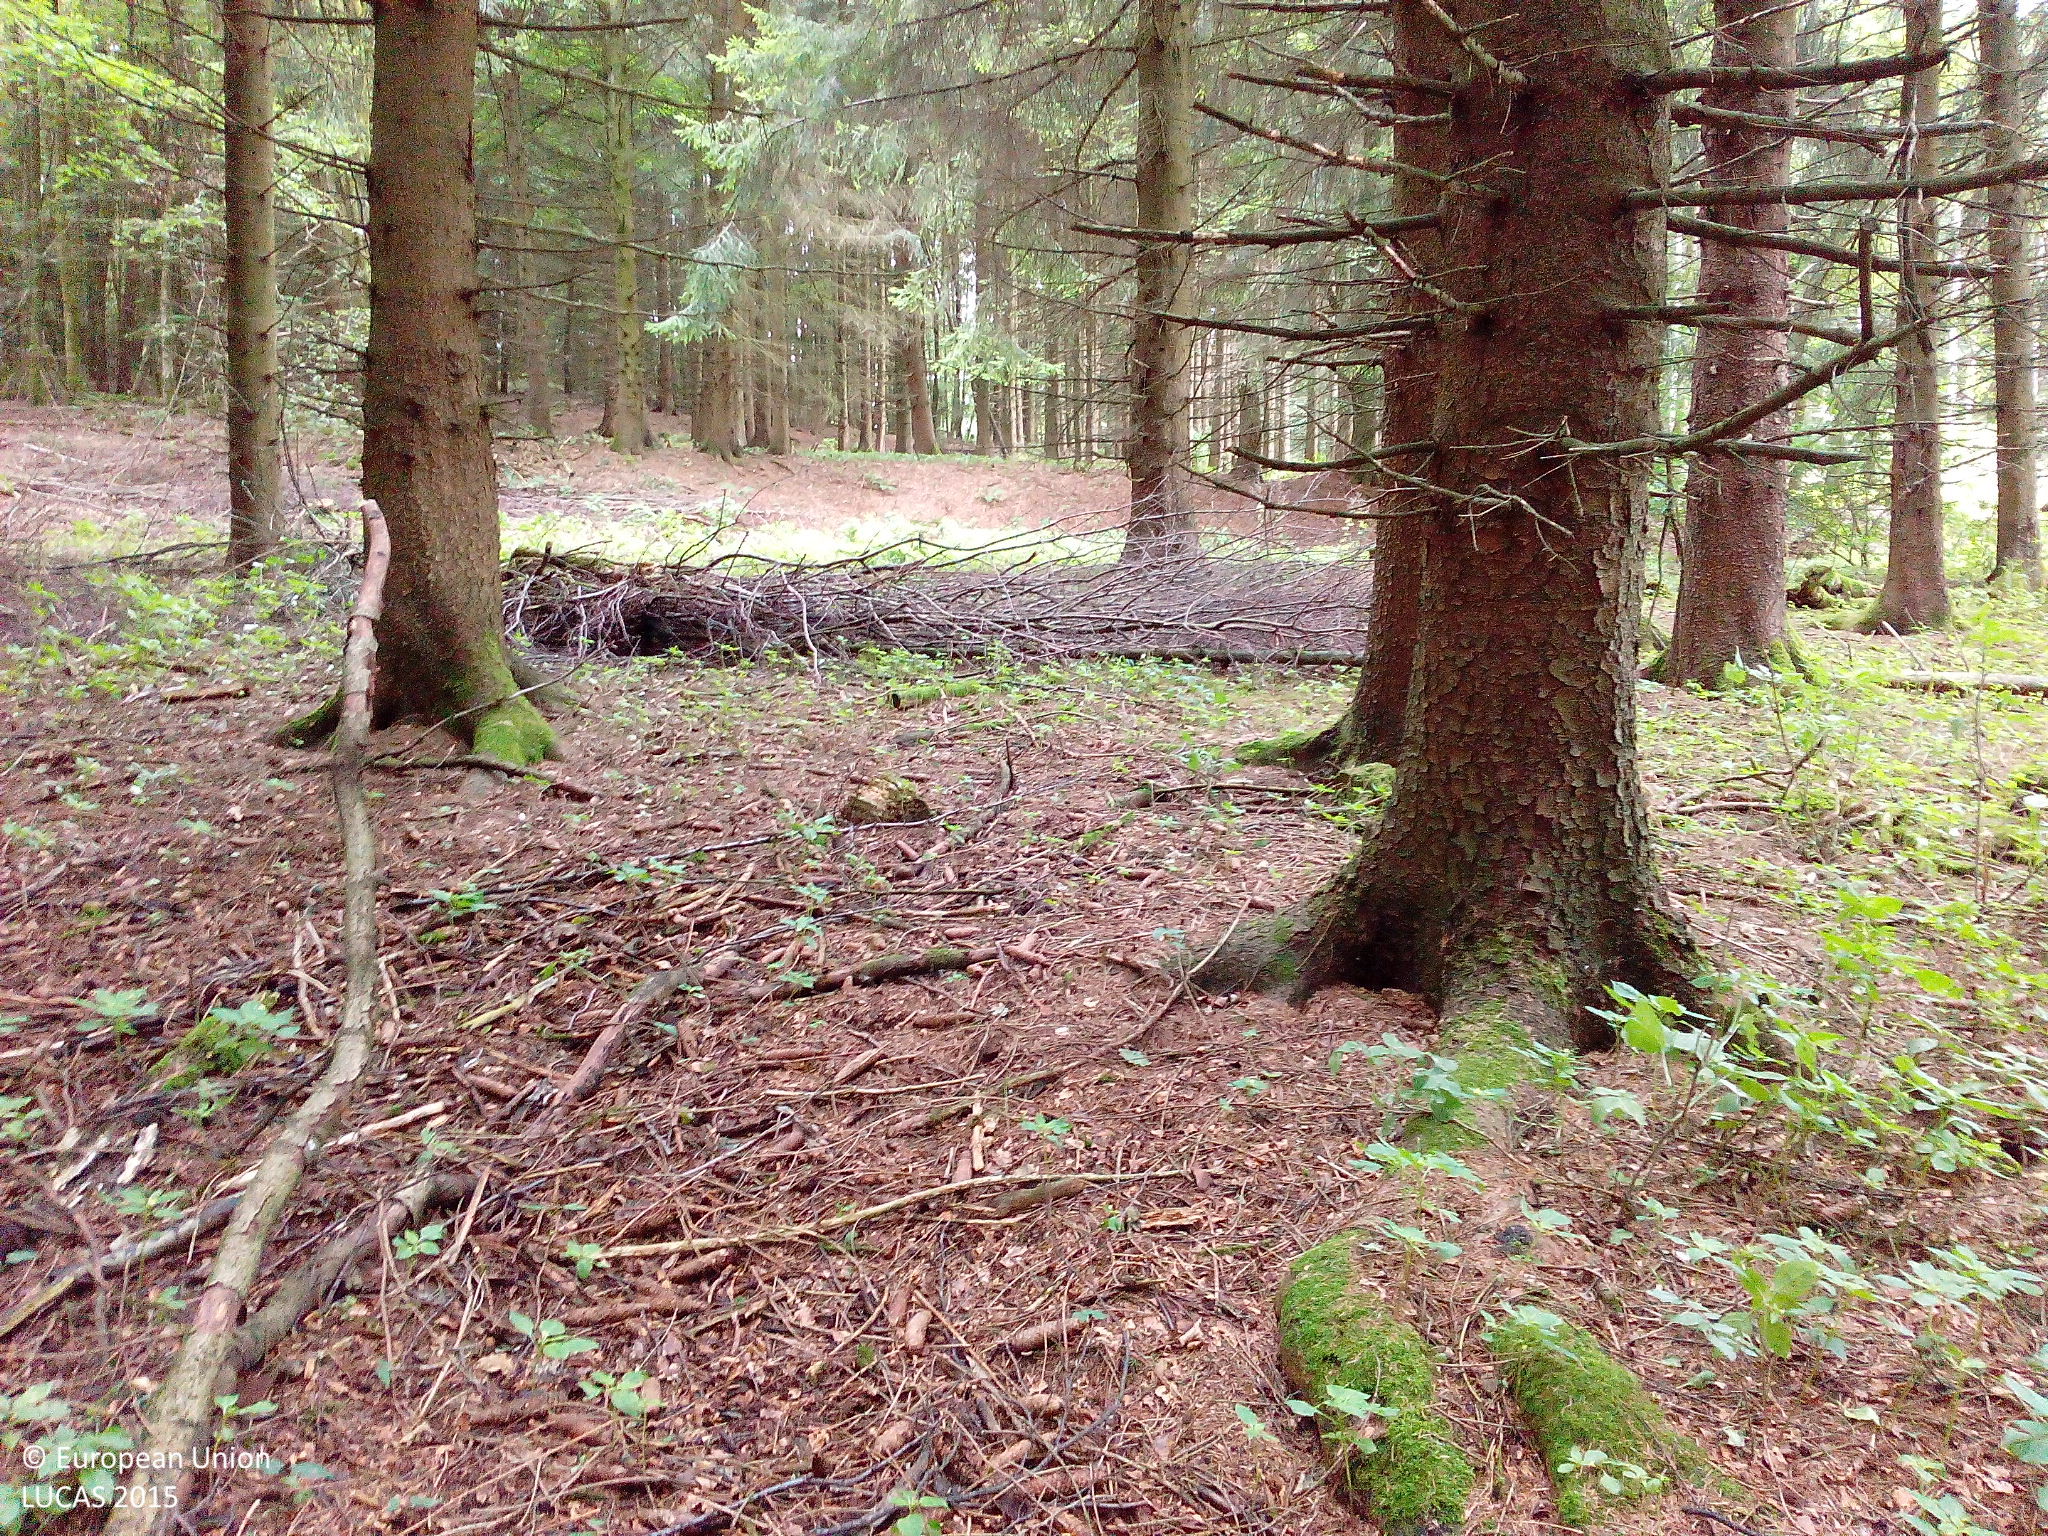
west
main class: Woodland
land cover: Spruce dominated coniferous woodland
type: hemiboreal forest and nemoral coniferous forest and mixed broadleaved-coniferous forest
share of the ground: > 75 %
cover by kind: coniferous forest trees 80 %, broadleaved forest trees 10 %, lichens and mosses 5 %, unconsolidated bare surface 5 %
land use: Forestry
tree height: > 5 m
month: August
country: DE
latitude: 50.3976
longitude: 9.2546
